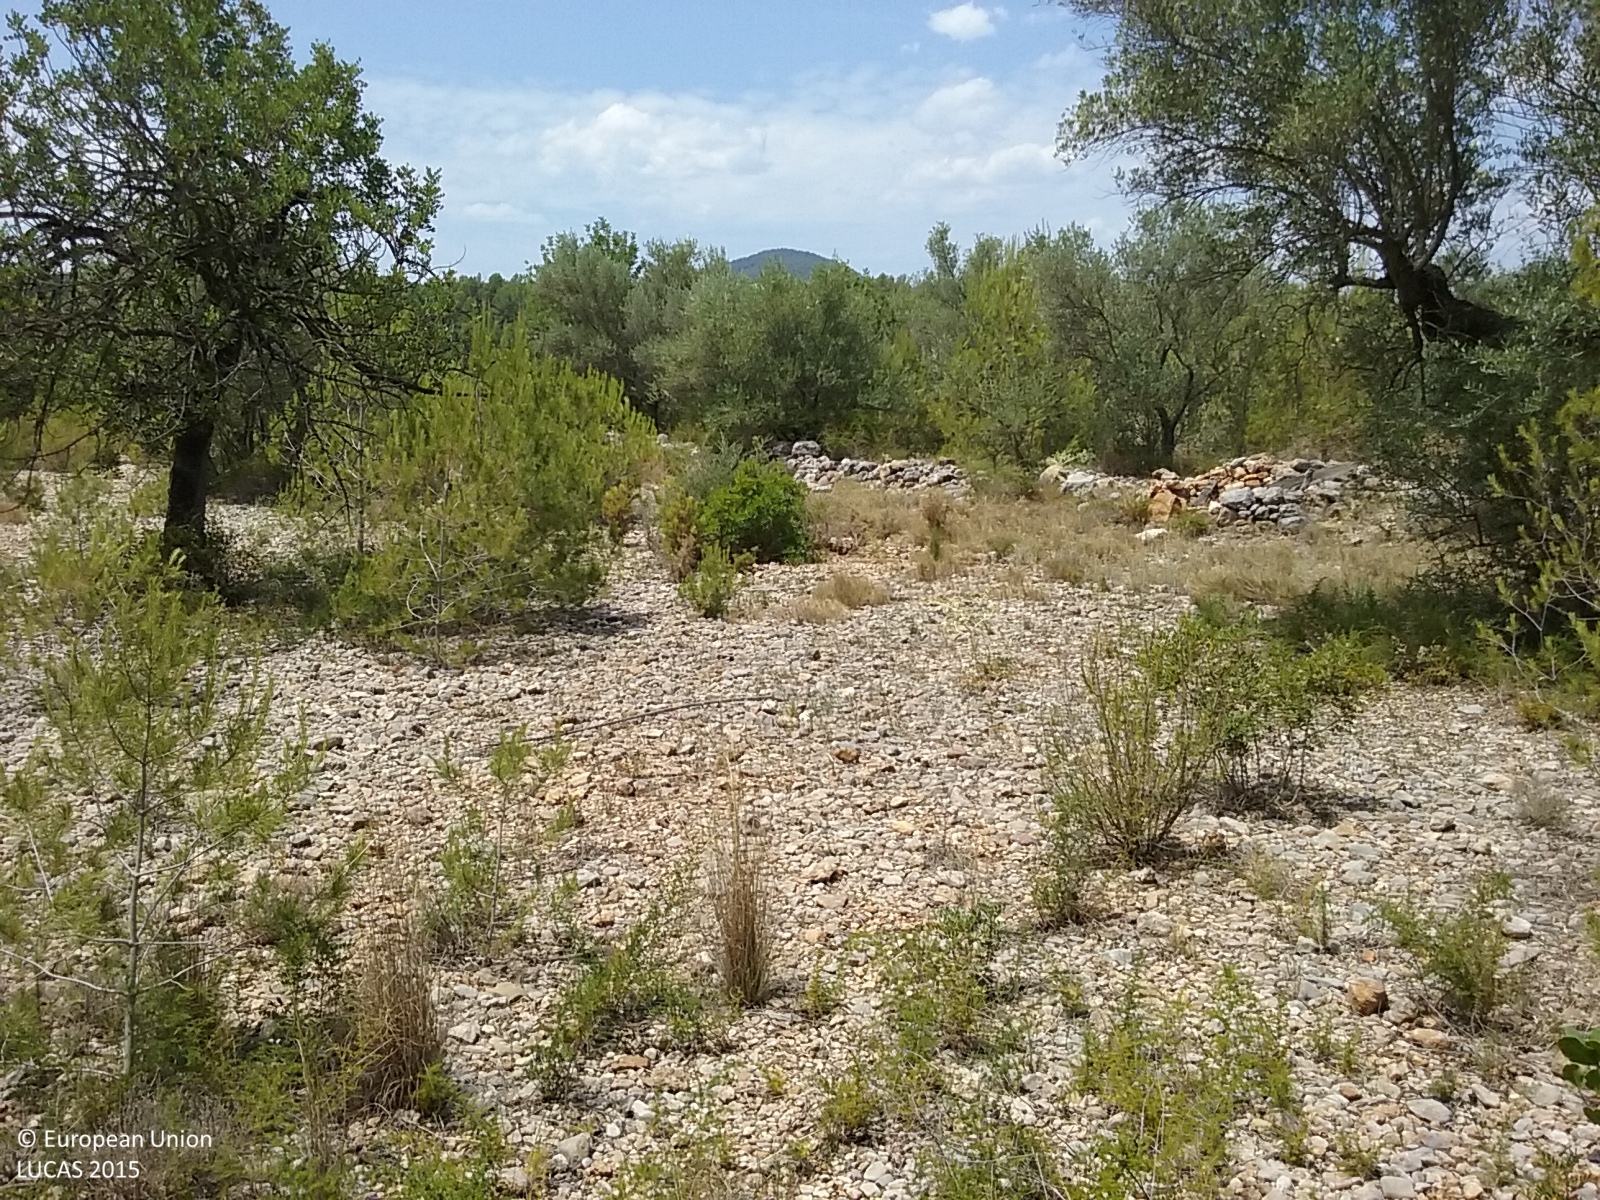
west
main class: Cropland
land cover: Permanent industrial crops
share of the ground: 10 - 25 %
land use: Abandoned areas
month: July
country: ES
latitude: 40.2570
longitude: -0.0799
